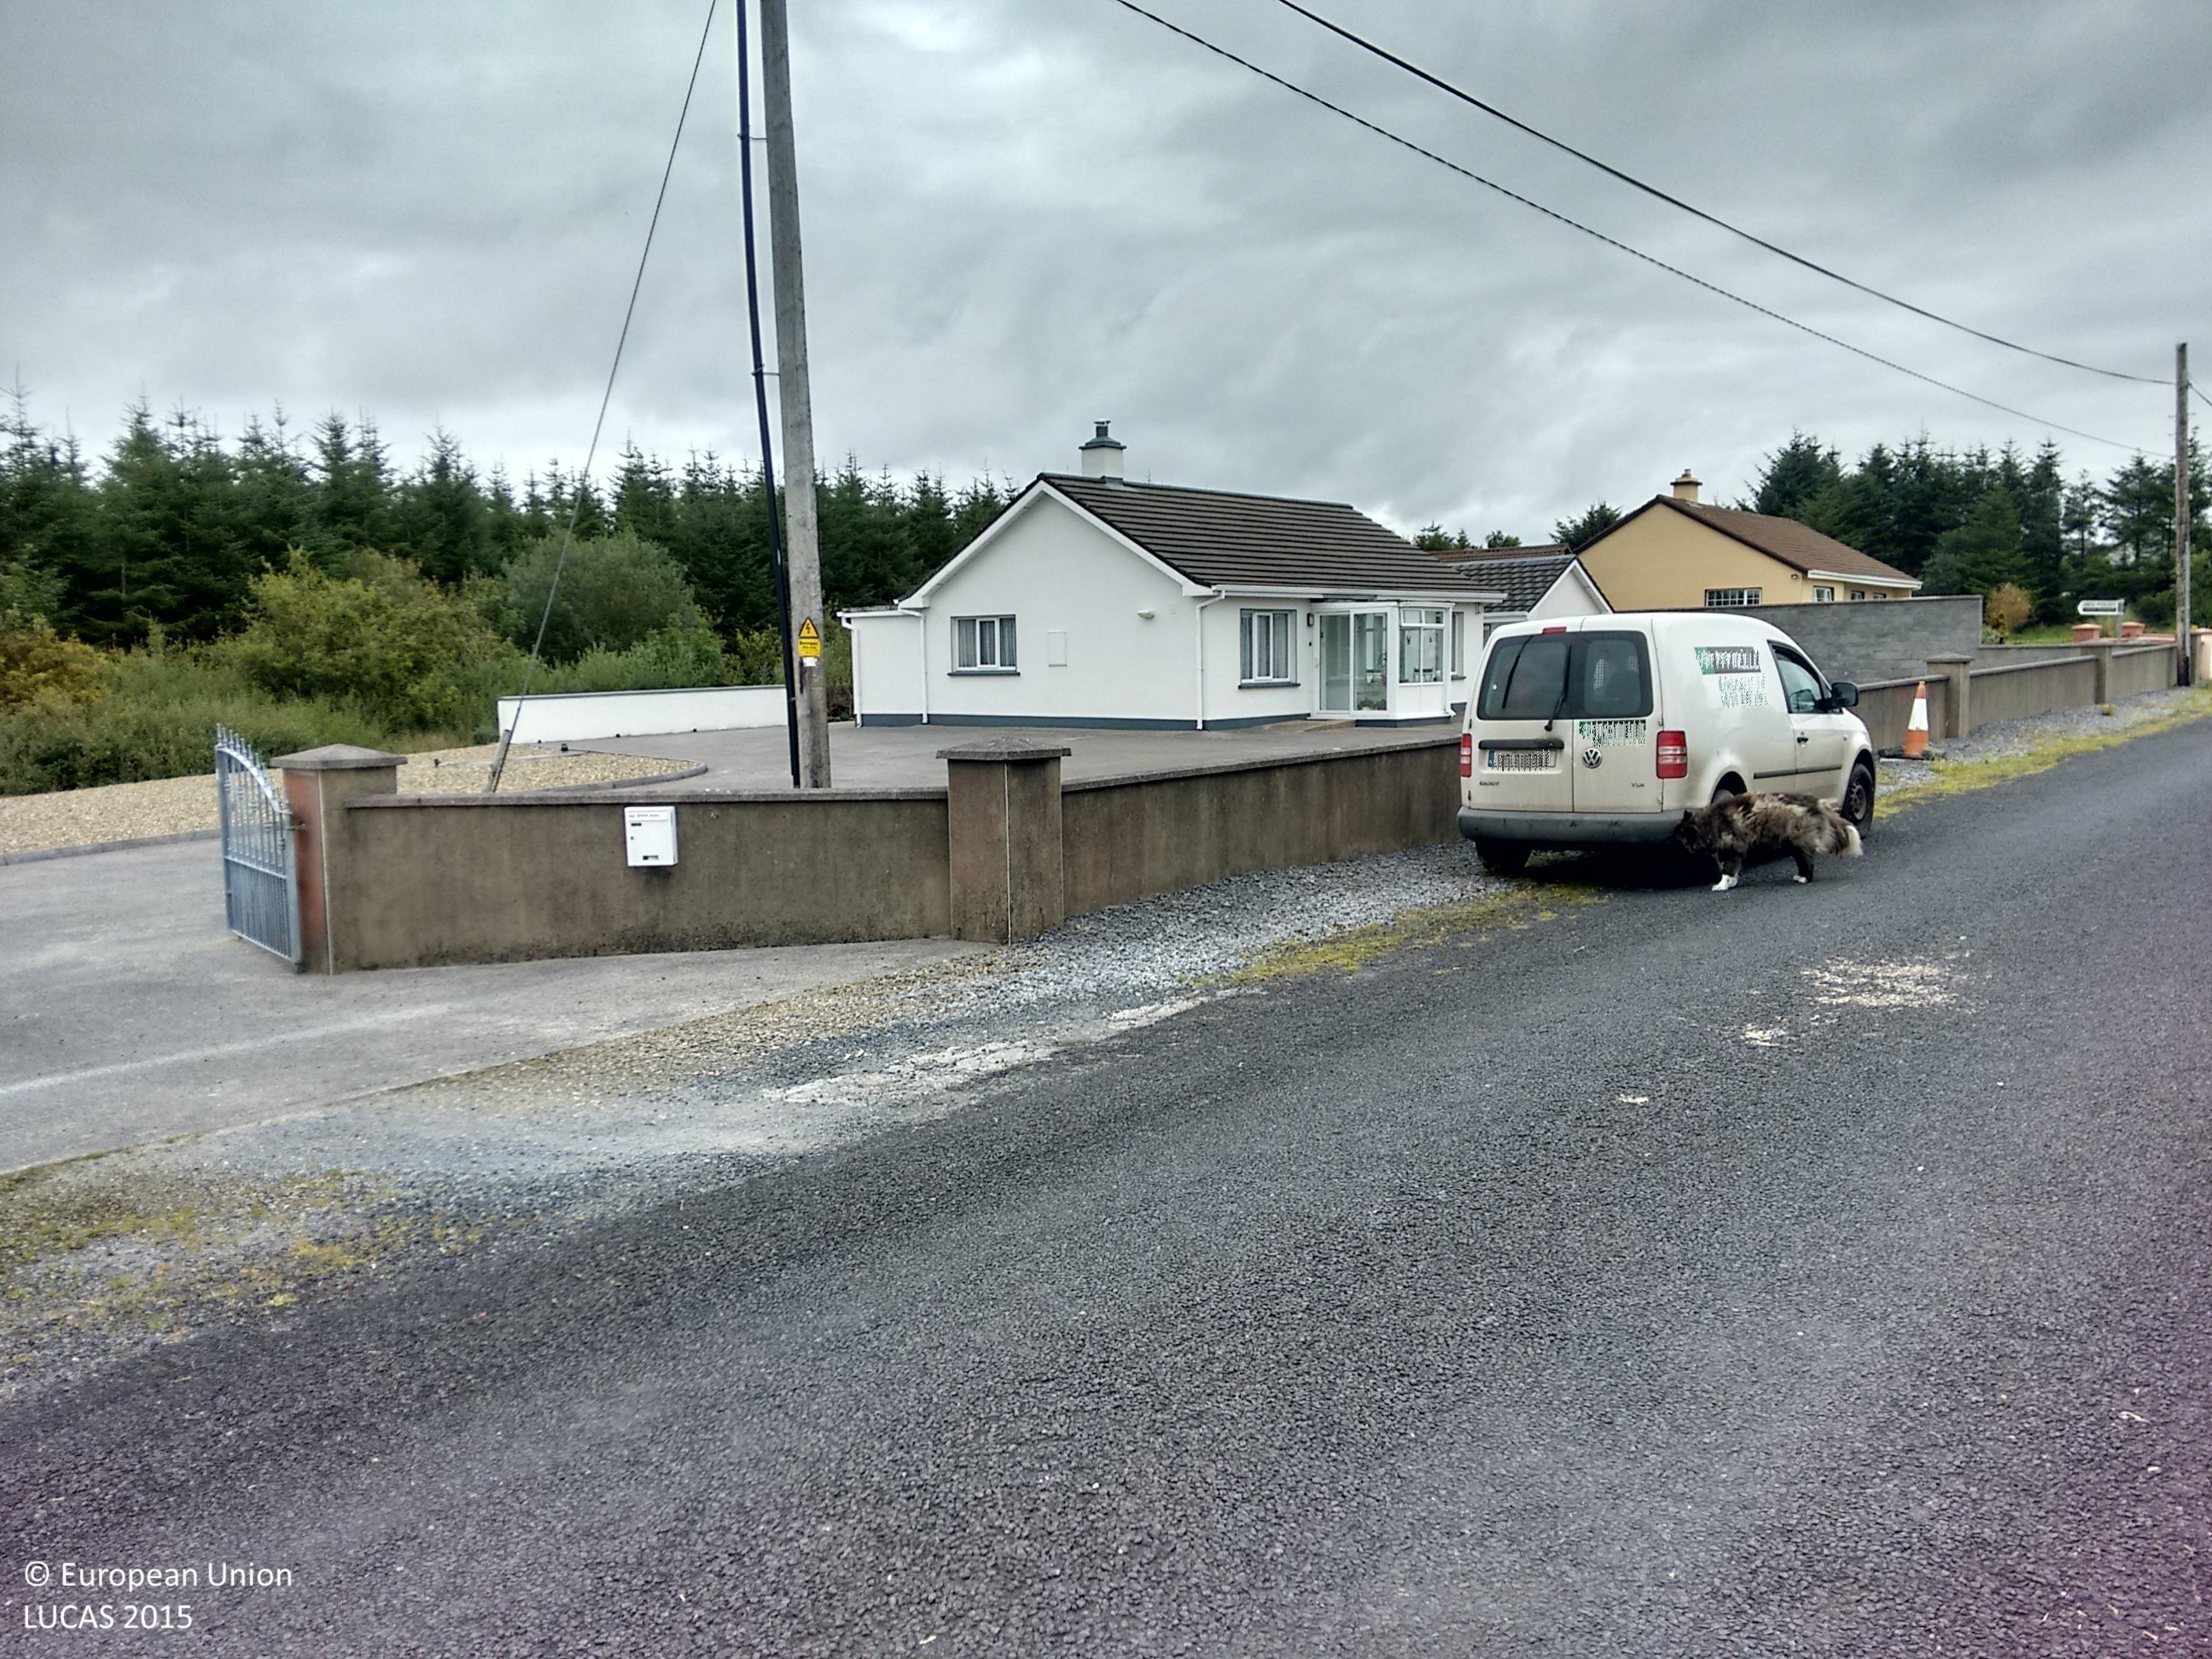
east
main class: Grassland
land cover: Grassland without tree/shrub cover
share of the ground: > 75 %
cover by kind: herbaceous plants 100 %
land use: Agriculture (excluding fallow land and kitchen gardens)
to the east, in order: Grassland without tree/shrub cover; Fences; Abandoned hedges; Grass margins; Artificial constructions in urban areas; Broadleaved woodland; Other coniferous woodland; Broadleaved woodland; Fences; Grassland without tree/shrub cover; Fences; Tracks; Fences; Grassland without tree/shrub cover
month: September
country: IE
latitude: 52.8338
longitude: -9.1442
